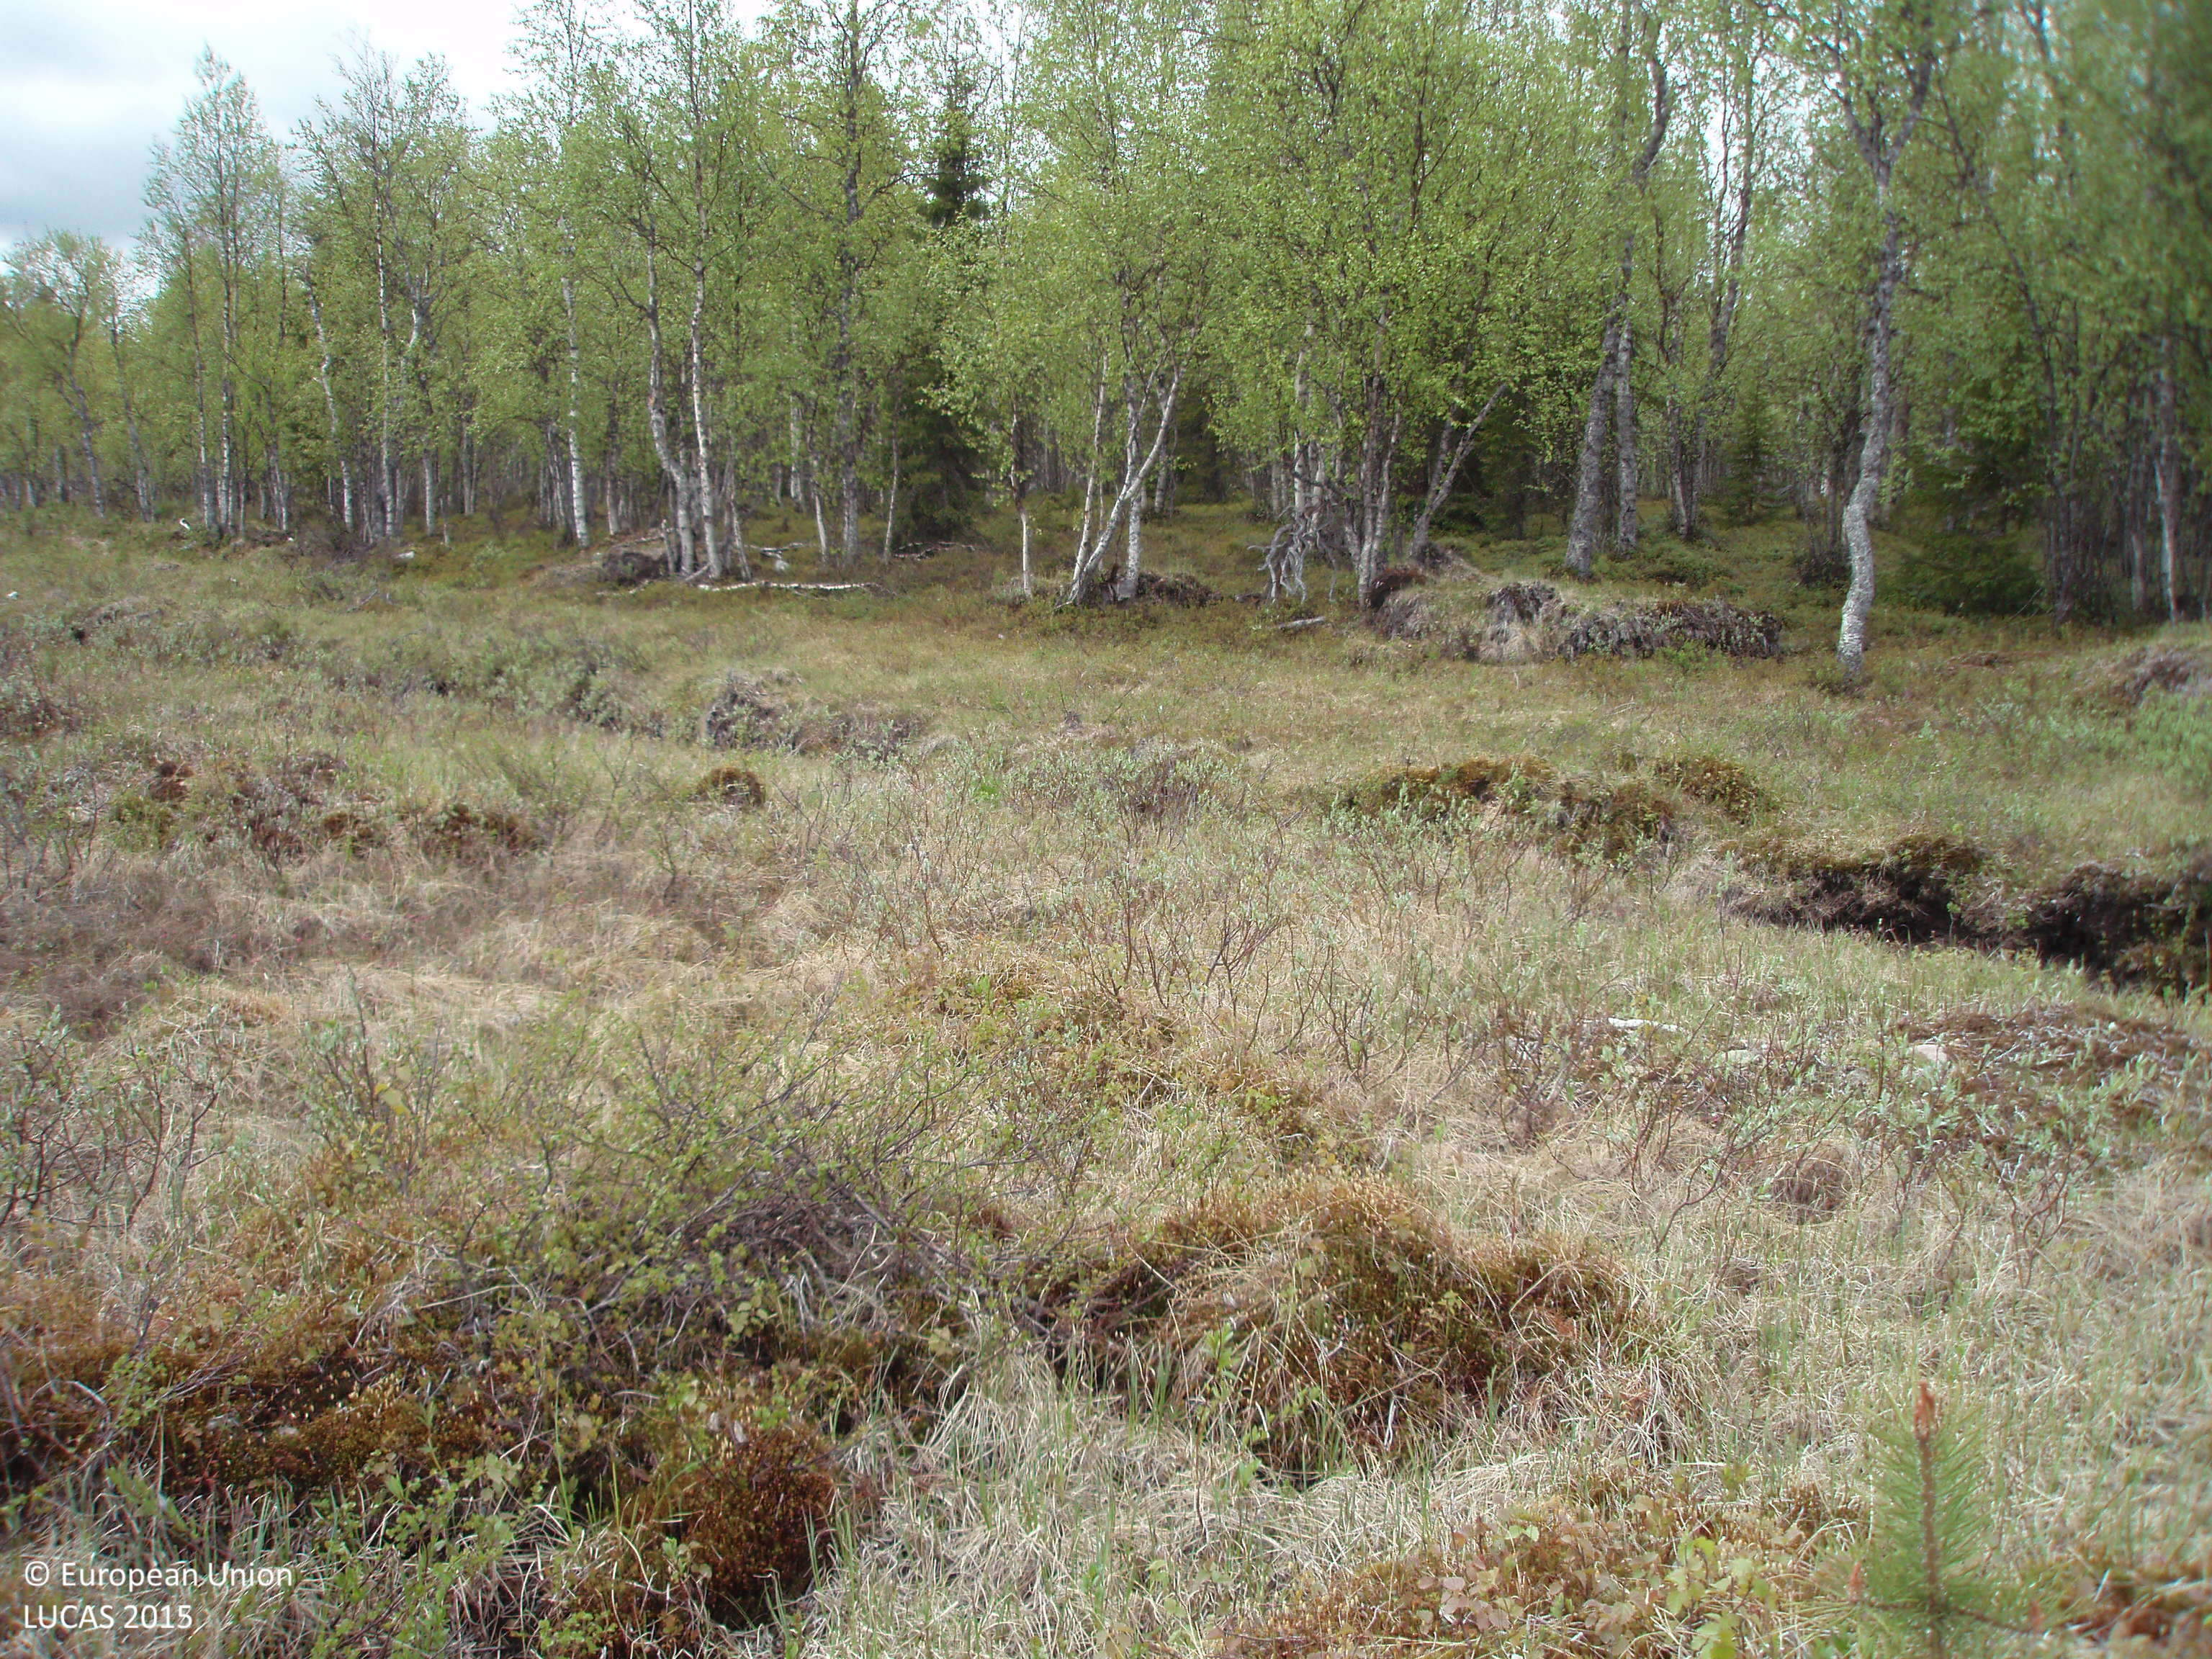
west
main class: Shrubland
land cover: Shrubland without tree cover
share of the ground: > 75 %
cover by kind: shrubs 60 %, herbaceous plants 40 %
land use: Semi-natural and natural areas not in use
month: June
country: FI
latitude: 67.9625
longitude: 26.7637
